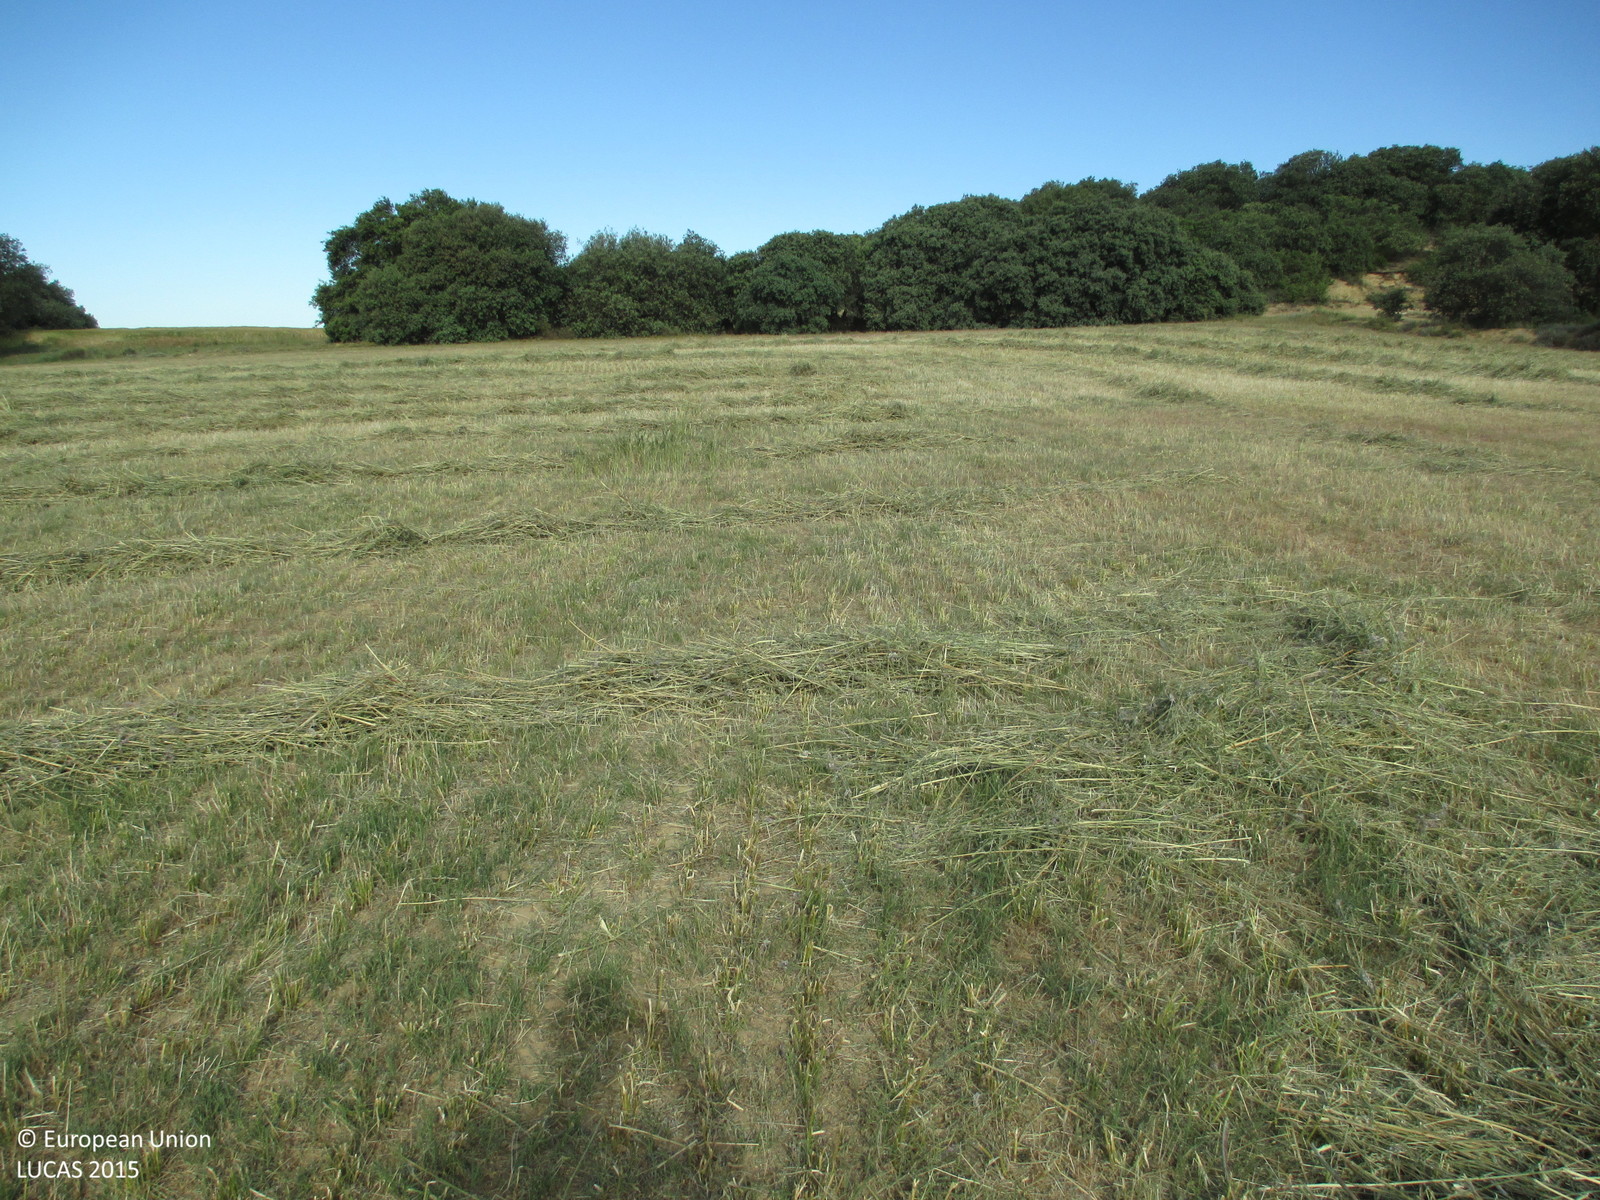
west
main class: Cropland
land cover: Lucerne
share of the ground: > 75 %
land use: Agriculture (excluding fallow land and kitchen gardens)
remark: Harvested field
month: May
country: ES
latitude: 42.0951
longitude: -0.2621
